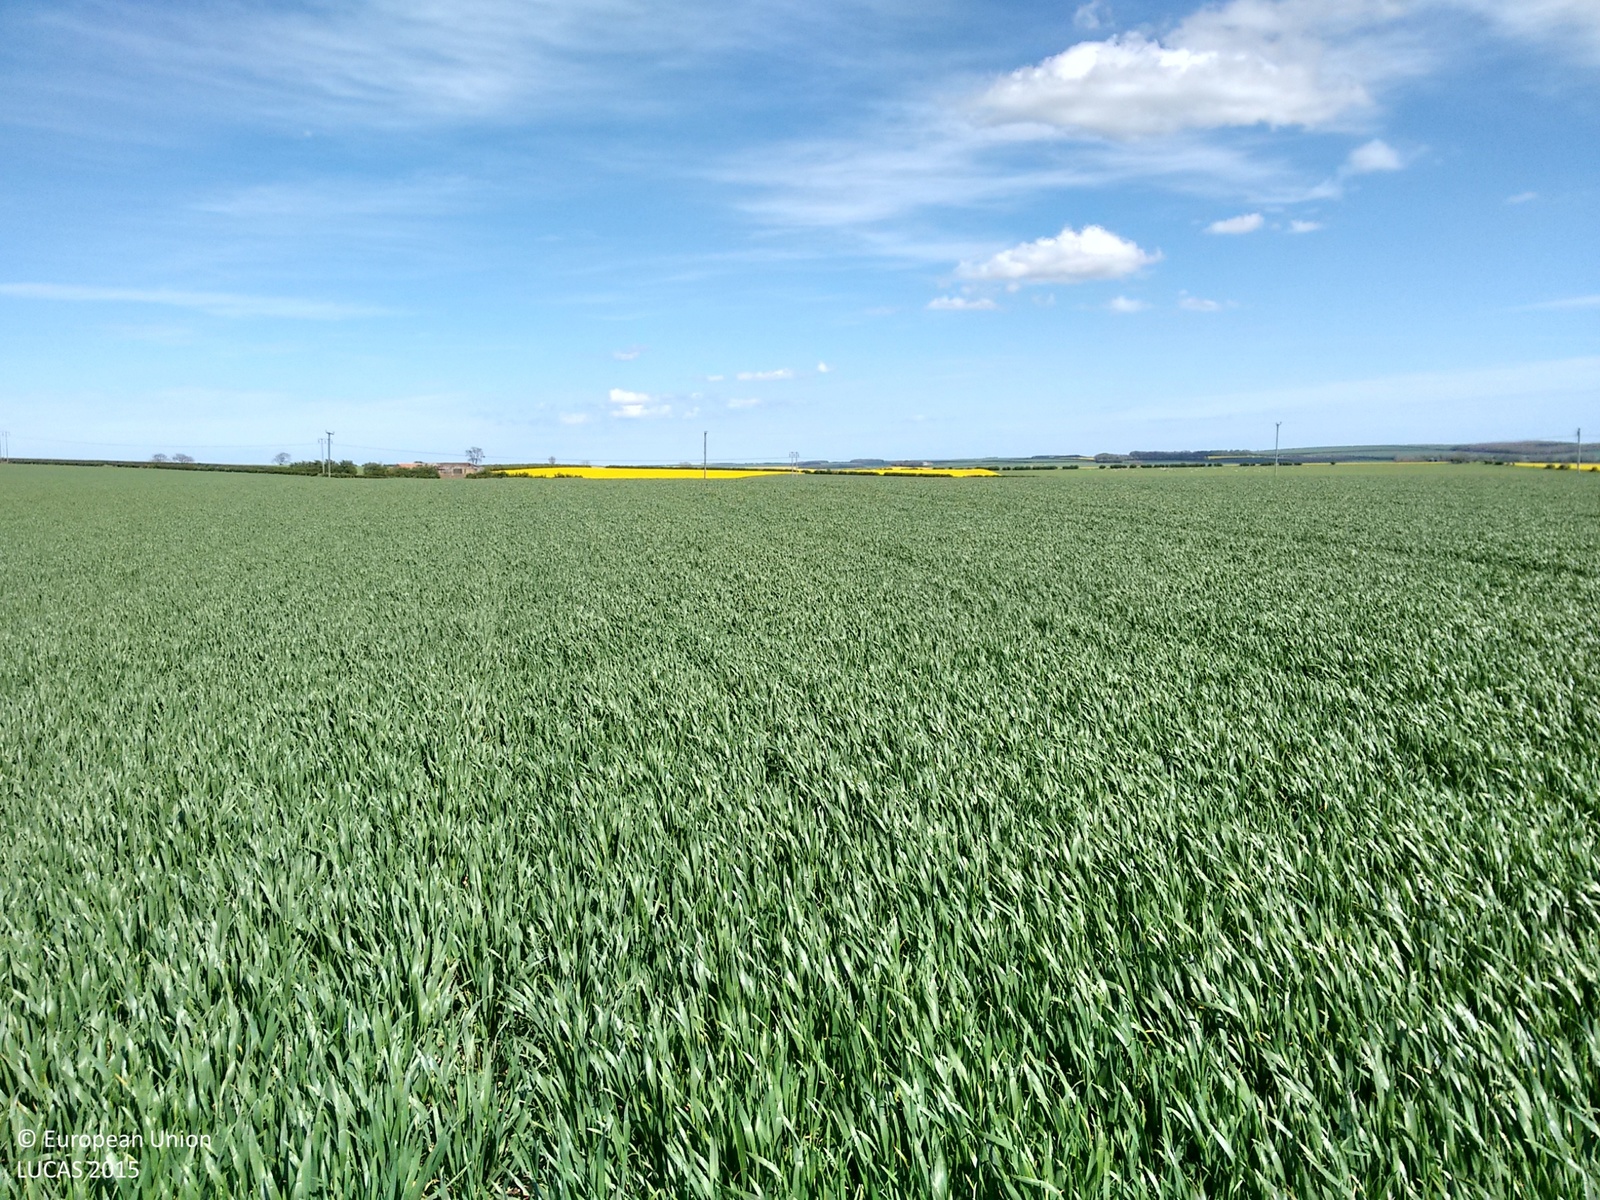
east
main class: Cropland
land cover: Common wheat
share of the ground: > 75 %
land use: Agriculture (excluding fallow land and kitchen gardens)
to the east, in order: Common wheat; Electric lines; Common wheat
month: May
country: GB
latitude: 54.1167
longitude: -0.3613
